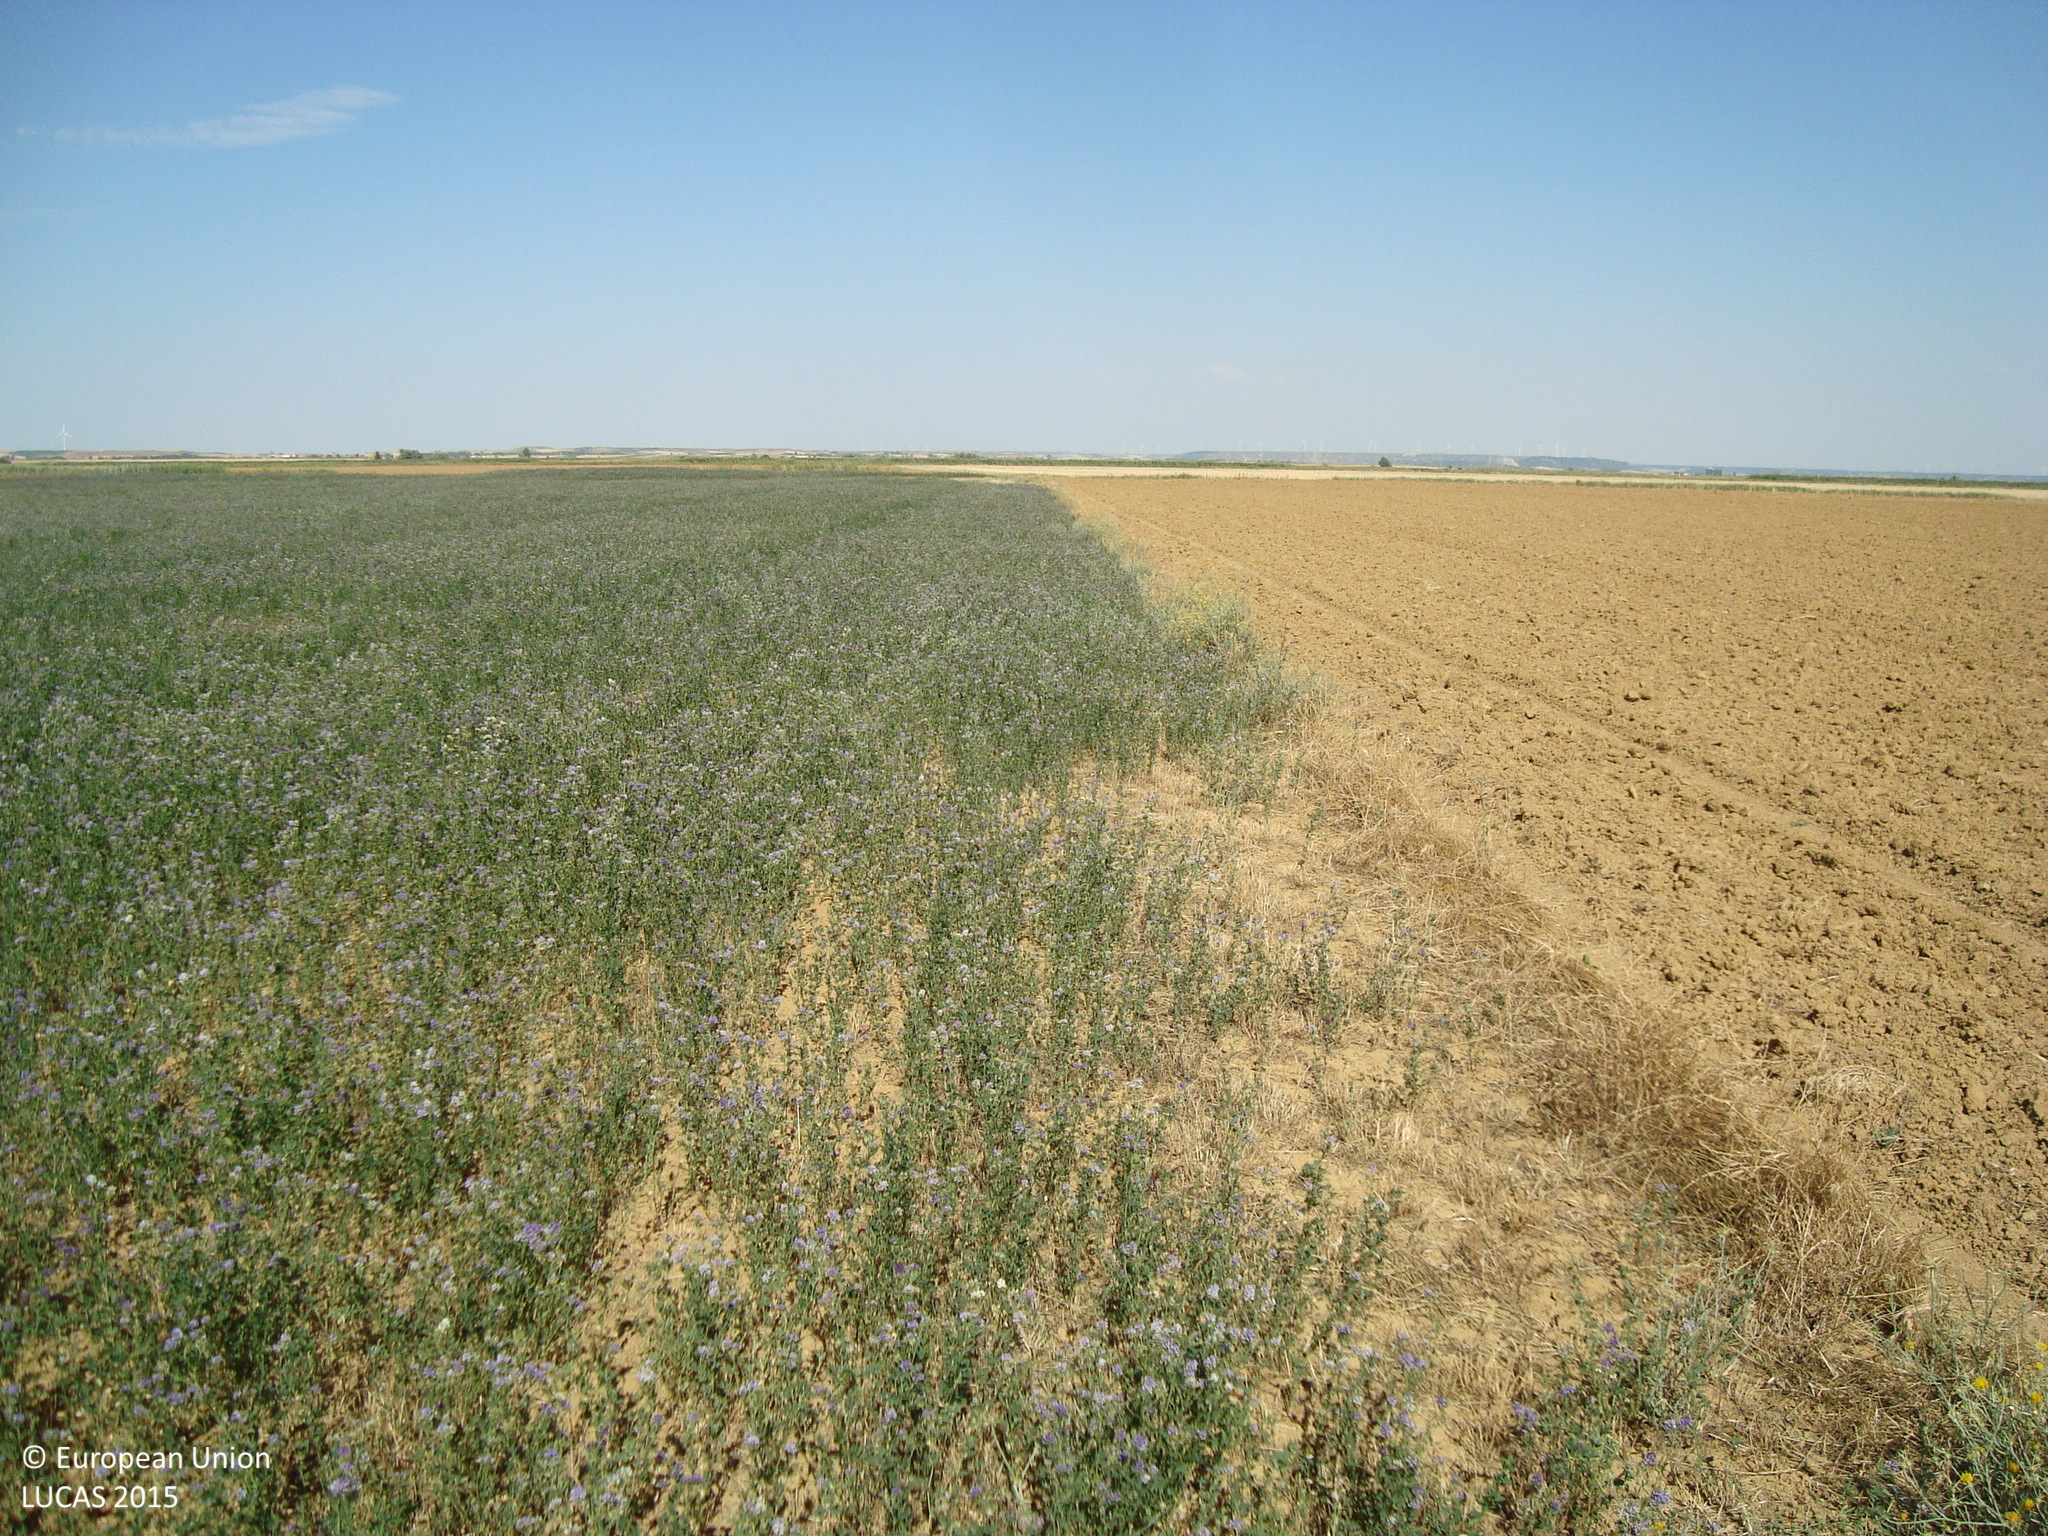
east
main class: Cropland
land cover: Lucerne
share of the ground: > 75 %
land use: Agriculture (excluding fallow land and kitchen gardens)
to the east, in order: Lucerne; Grass margins; Other bare soil; Rivers and streams; Barley
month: July
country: ES
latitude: 42.0823
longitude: -4.7379
